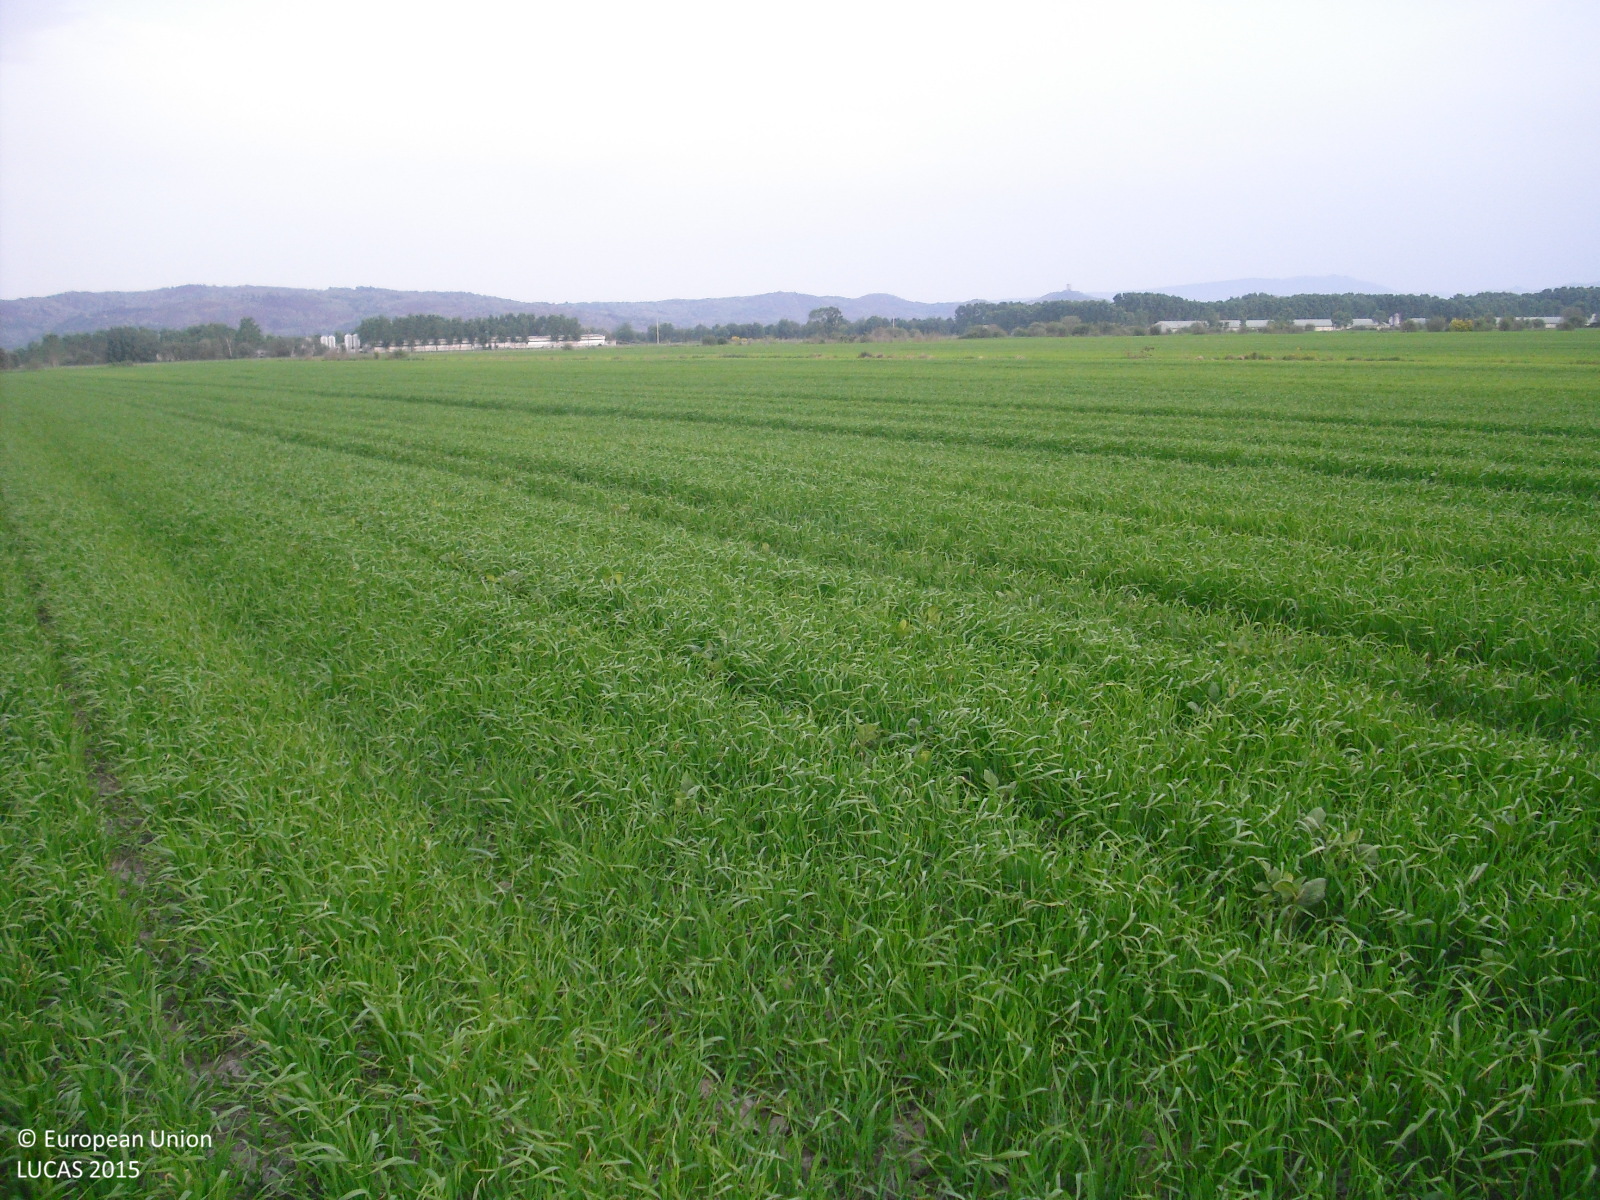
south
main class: Cropland
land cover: Common wheat
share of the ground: > 75 %
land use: Agriculture (excluding fallow land and kitchen gardens)
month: May
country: ES
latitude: 42.1367
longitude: -7.6726
